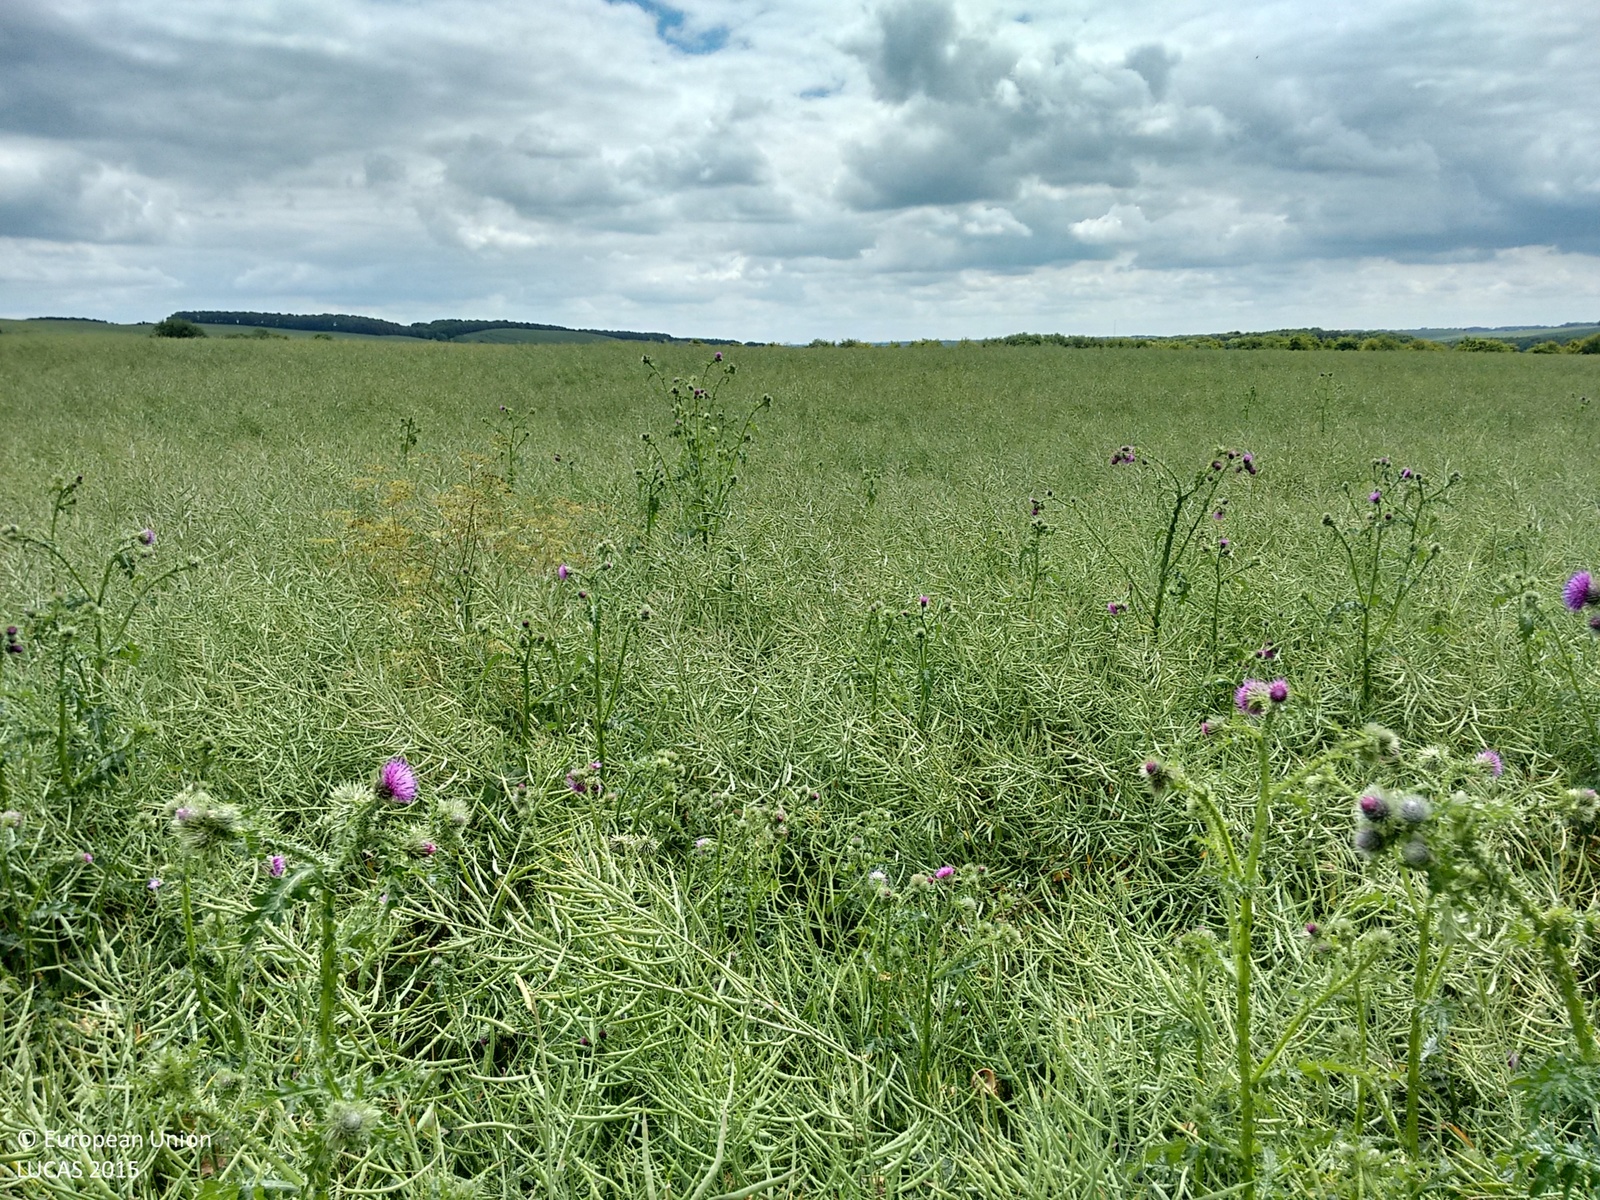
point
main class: Cropland
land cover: Rape and turnip rape
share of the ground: > 75 %
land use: Agriculture (excluding fallow land and kitchen gardens)
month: June
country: GB
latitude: 51.5723
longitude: -1.5806
